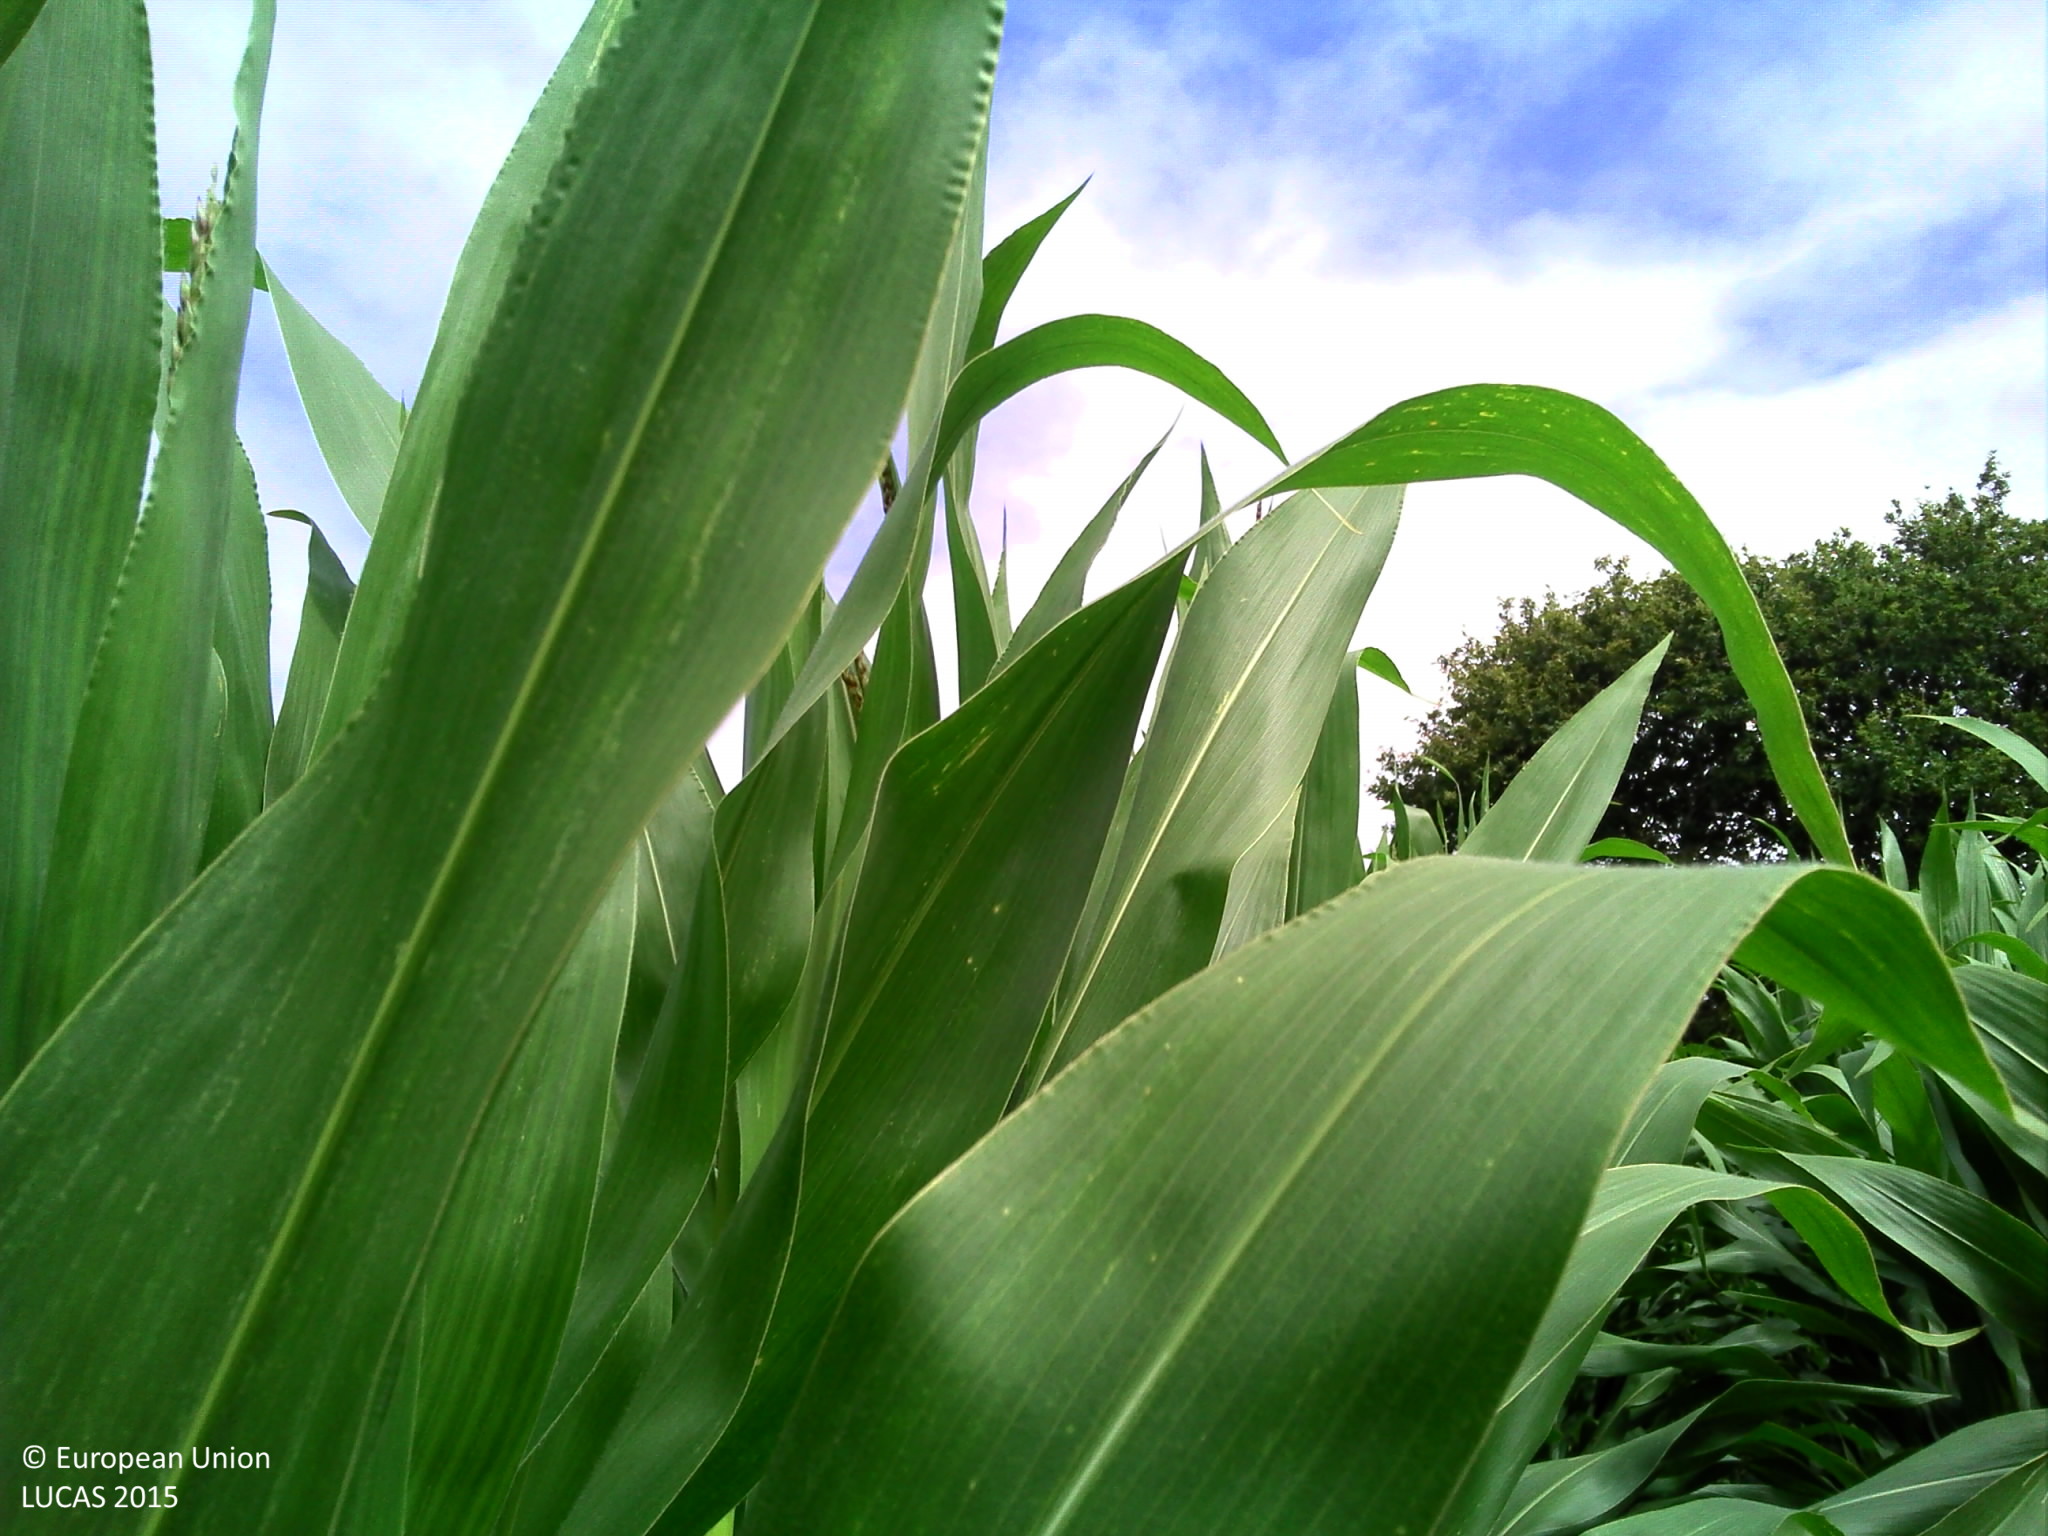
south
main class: Cropland
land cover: Maize
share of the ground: > 75 %
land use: Agriculture (excluding fallow land and kitchen gardens)
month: August
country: FR
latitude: 48.4590
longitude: -3.3969
